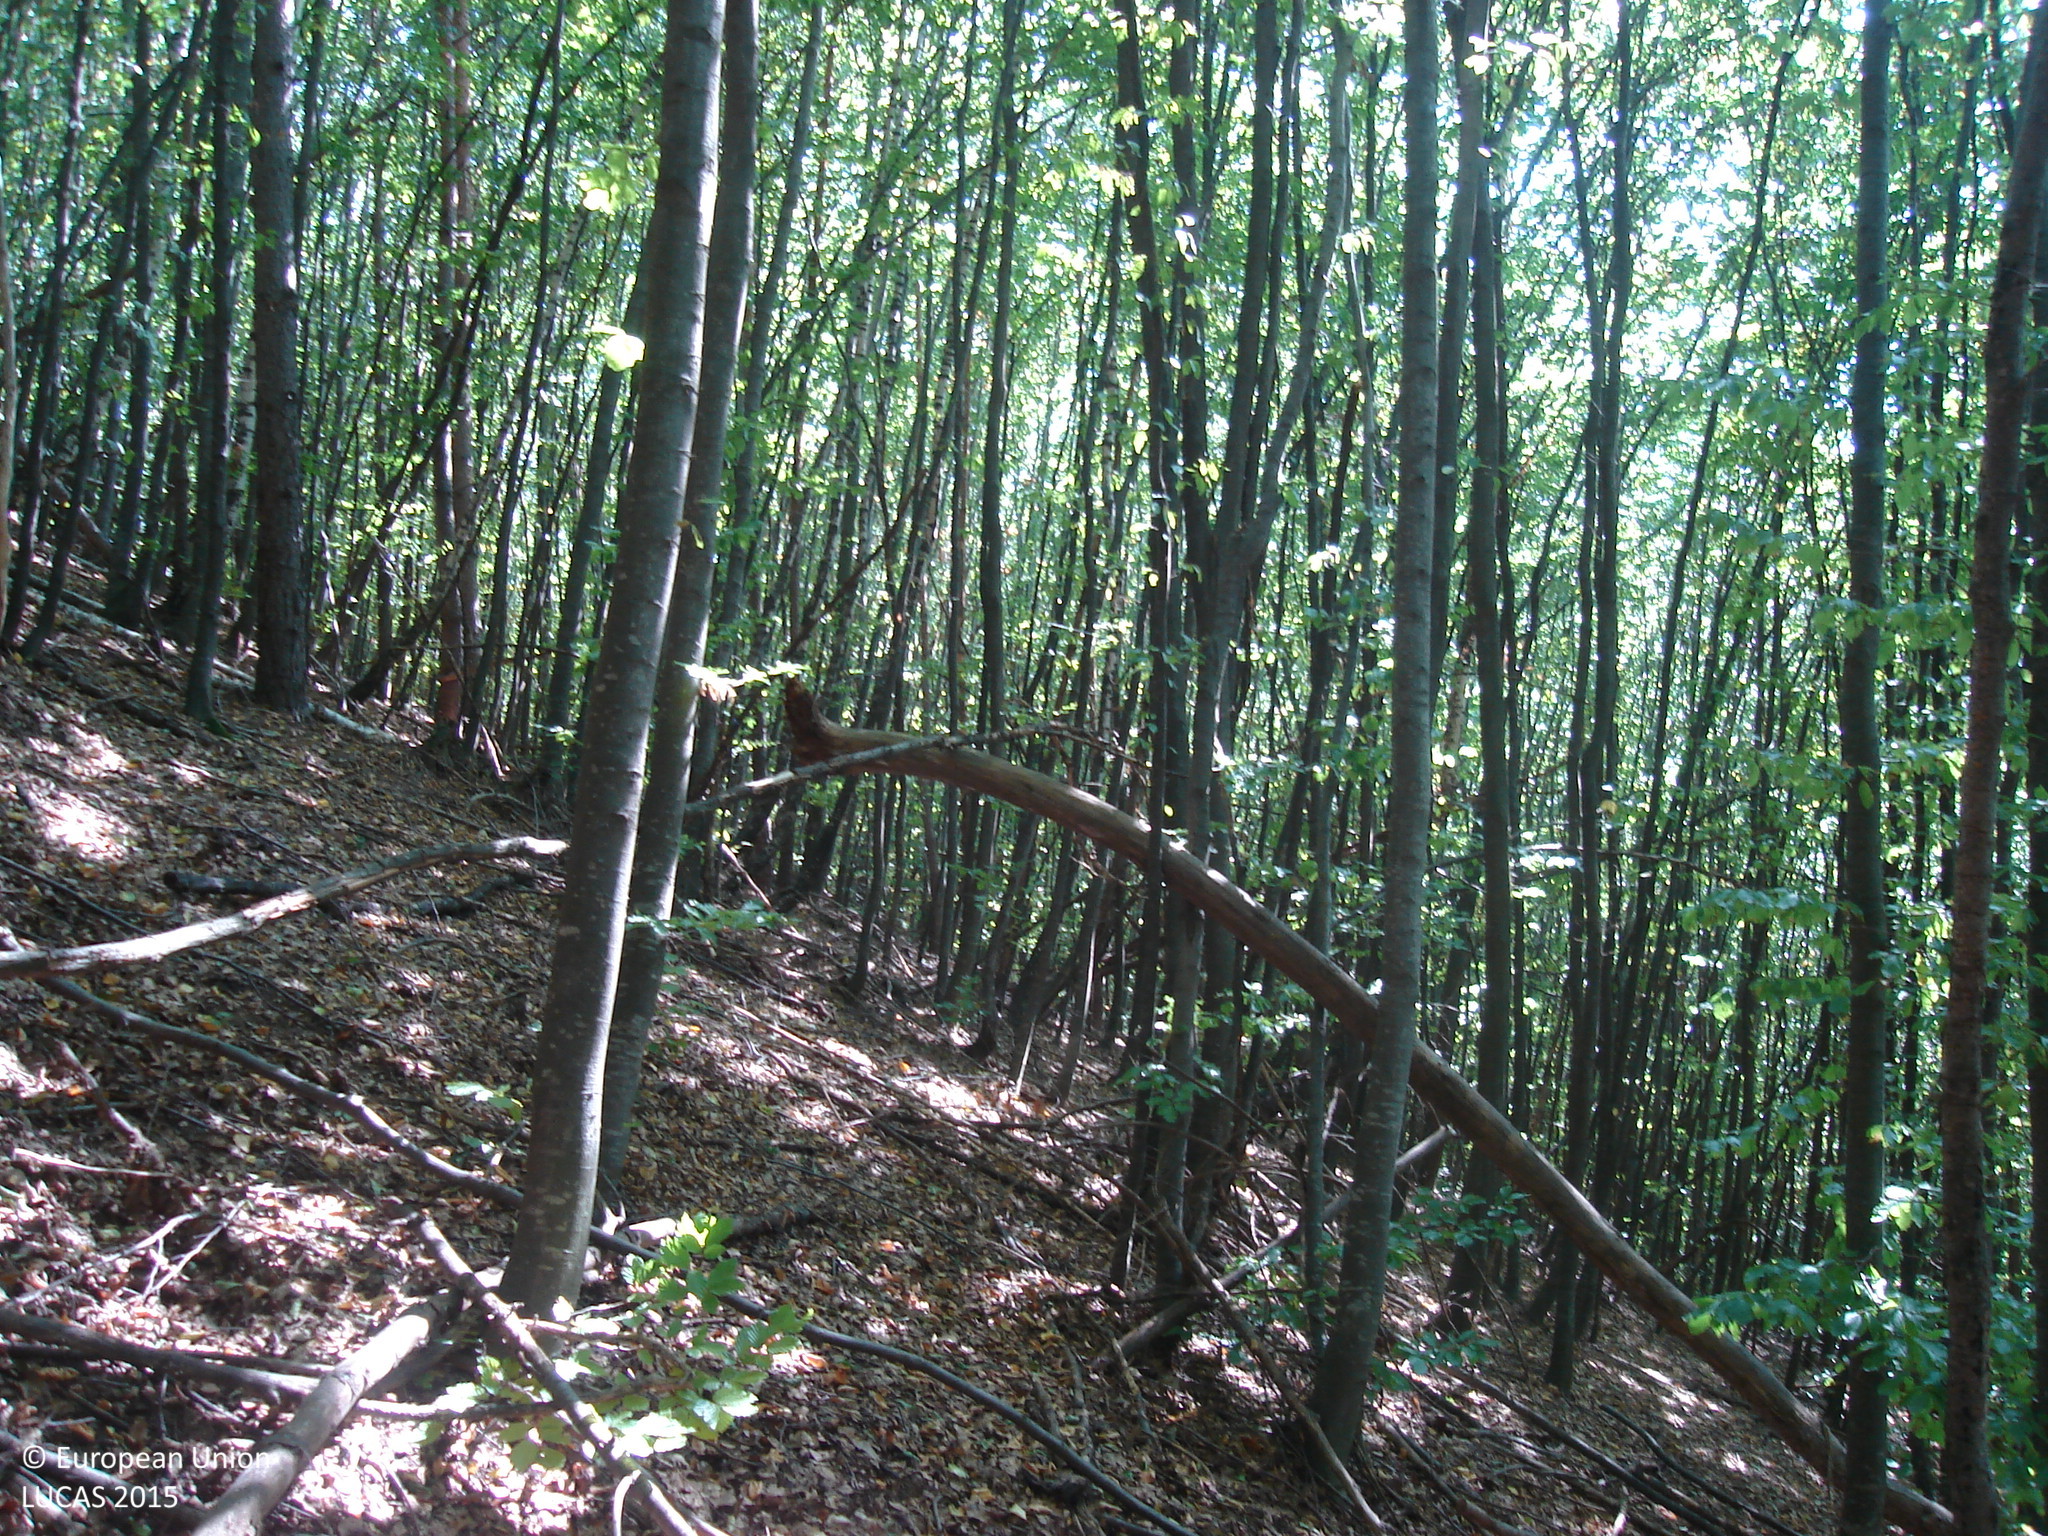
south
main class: Woodland
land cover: Broadleaved woodland
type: beech forest
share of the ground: > 75 %
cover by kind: broadleaved forest trees 80 %, consolidated bare surface 20 %
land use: Forestry
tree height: > 5 m
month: September
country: BG
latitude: 42.8108
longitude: 23.9995
